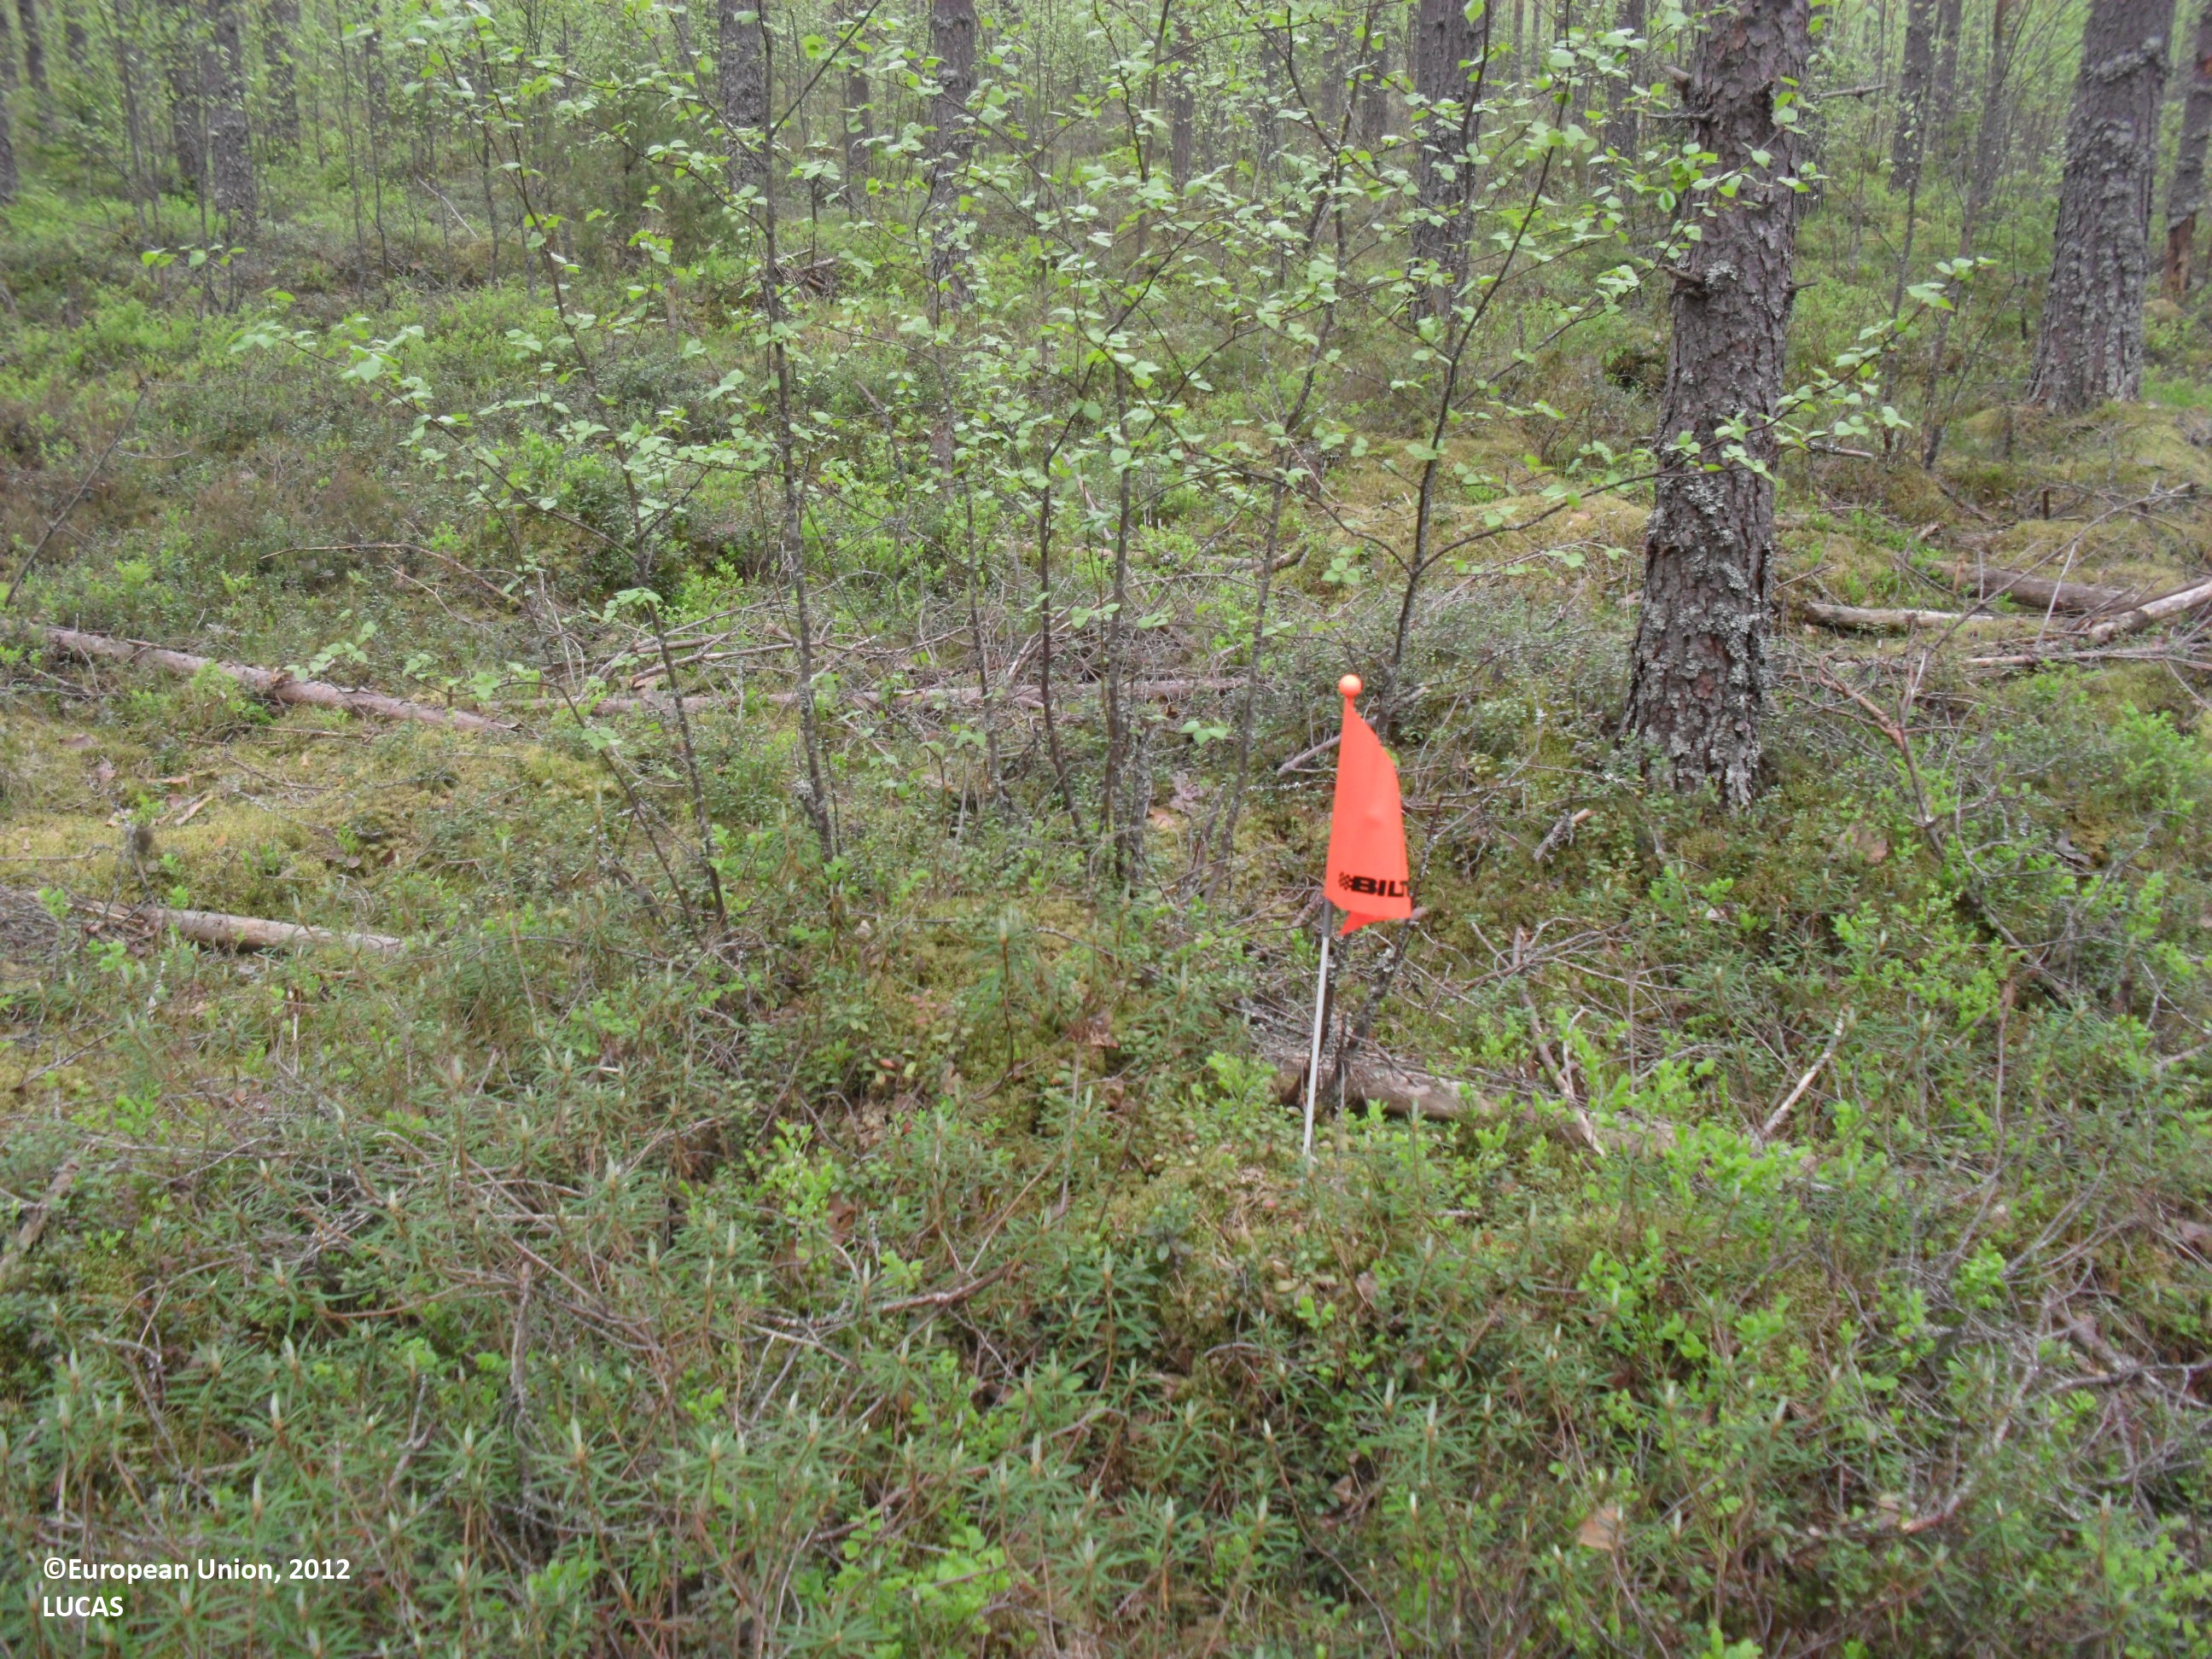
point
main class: Woodland
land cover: Pine dominated coniferous woodland
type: boreal forest
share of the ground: 50 - 75 %
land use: Forestry
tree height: > 5 m
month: June
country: FI
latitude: 63.0996
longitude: 23.3164
